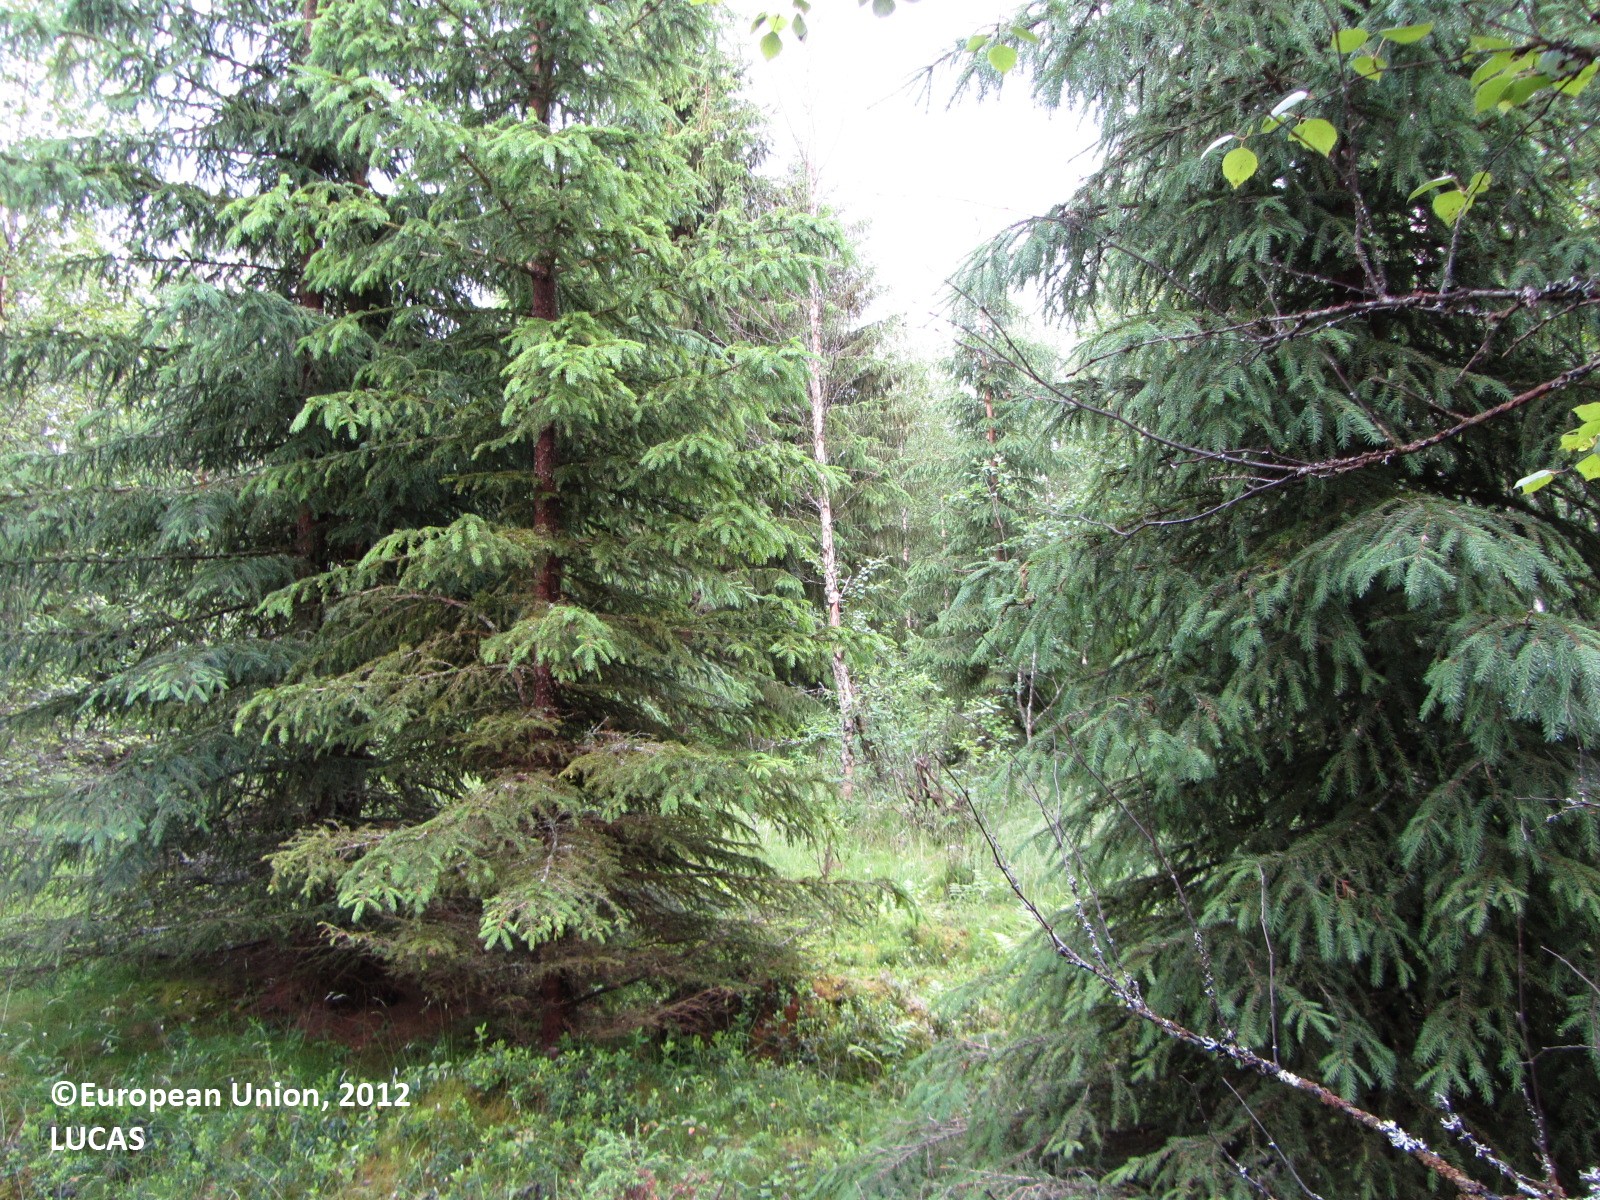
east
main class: Woodland
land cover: Spruce dominated mixed woodland
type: boreal forest
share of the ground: 50 - 75 %
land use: Forestry
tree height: > 5 m
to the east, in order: Spruce dominated mixed woodland; Grassland with sparse tree/shrub cover; Other mixed woodland; Shrubland with sparse tree cover; Spruce dominated mixed woodland; Ditches and canals; Spruce dominated mixed woodland; Shrubland with sparse tree cover; Other mixed woodland; Tracks; Other coniferous woodland; Other mixed woodland
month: July
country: FI
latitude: 63.8442
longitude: 25.5725
